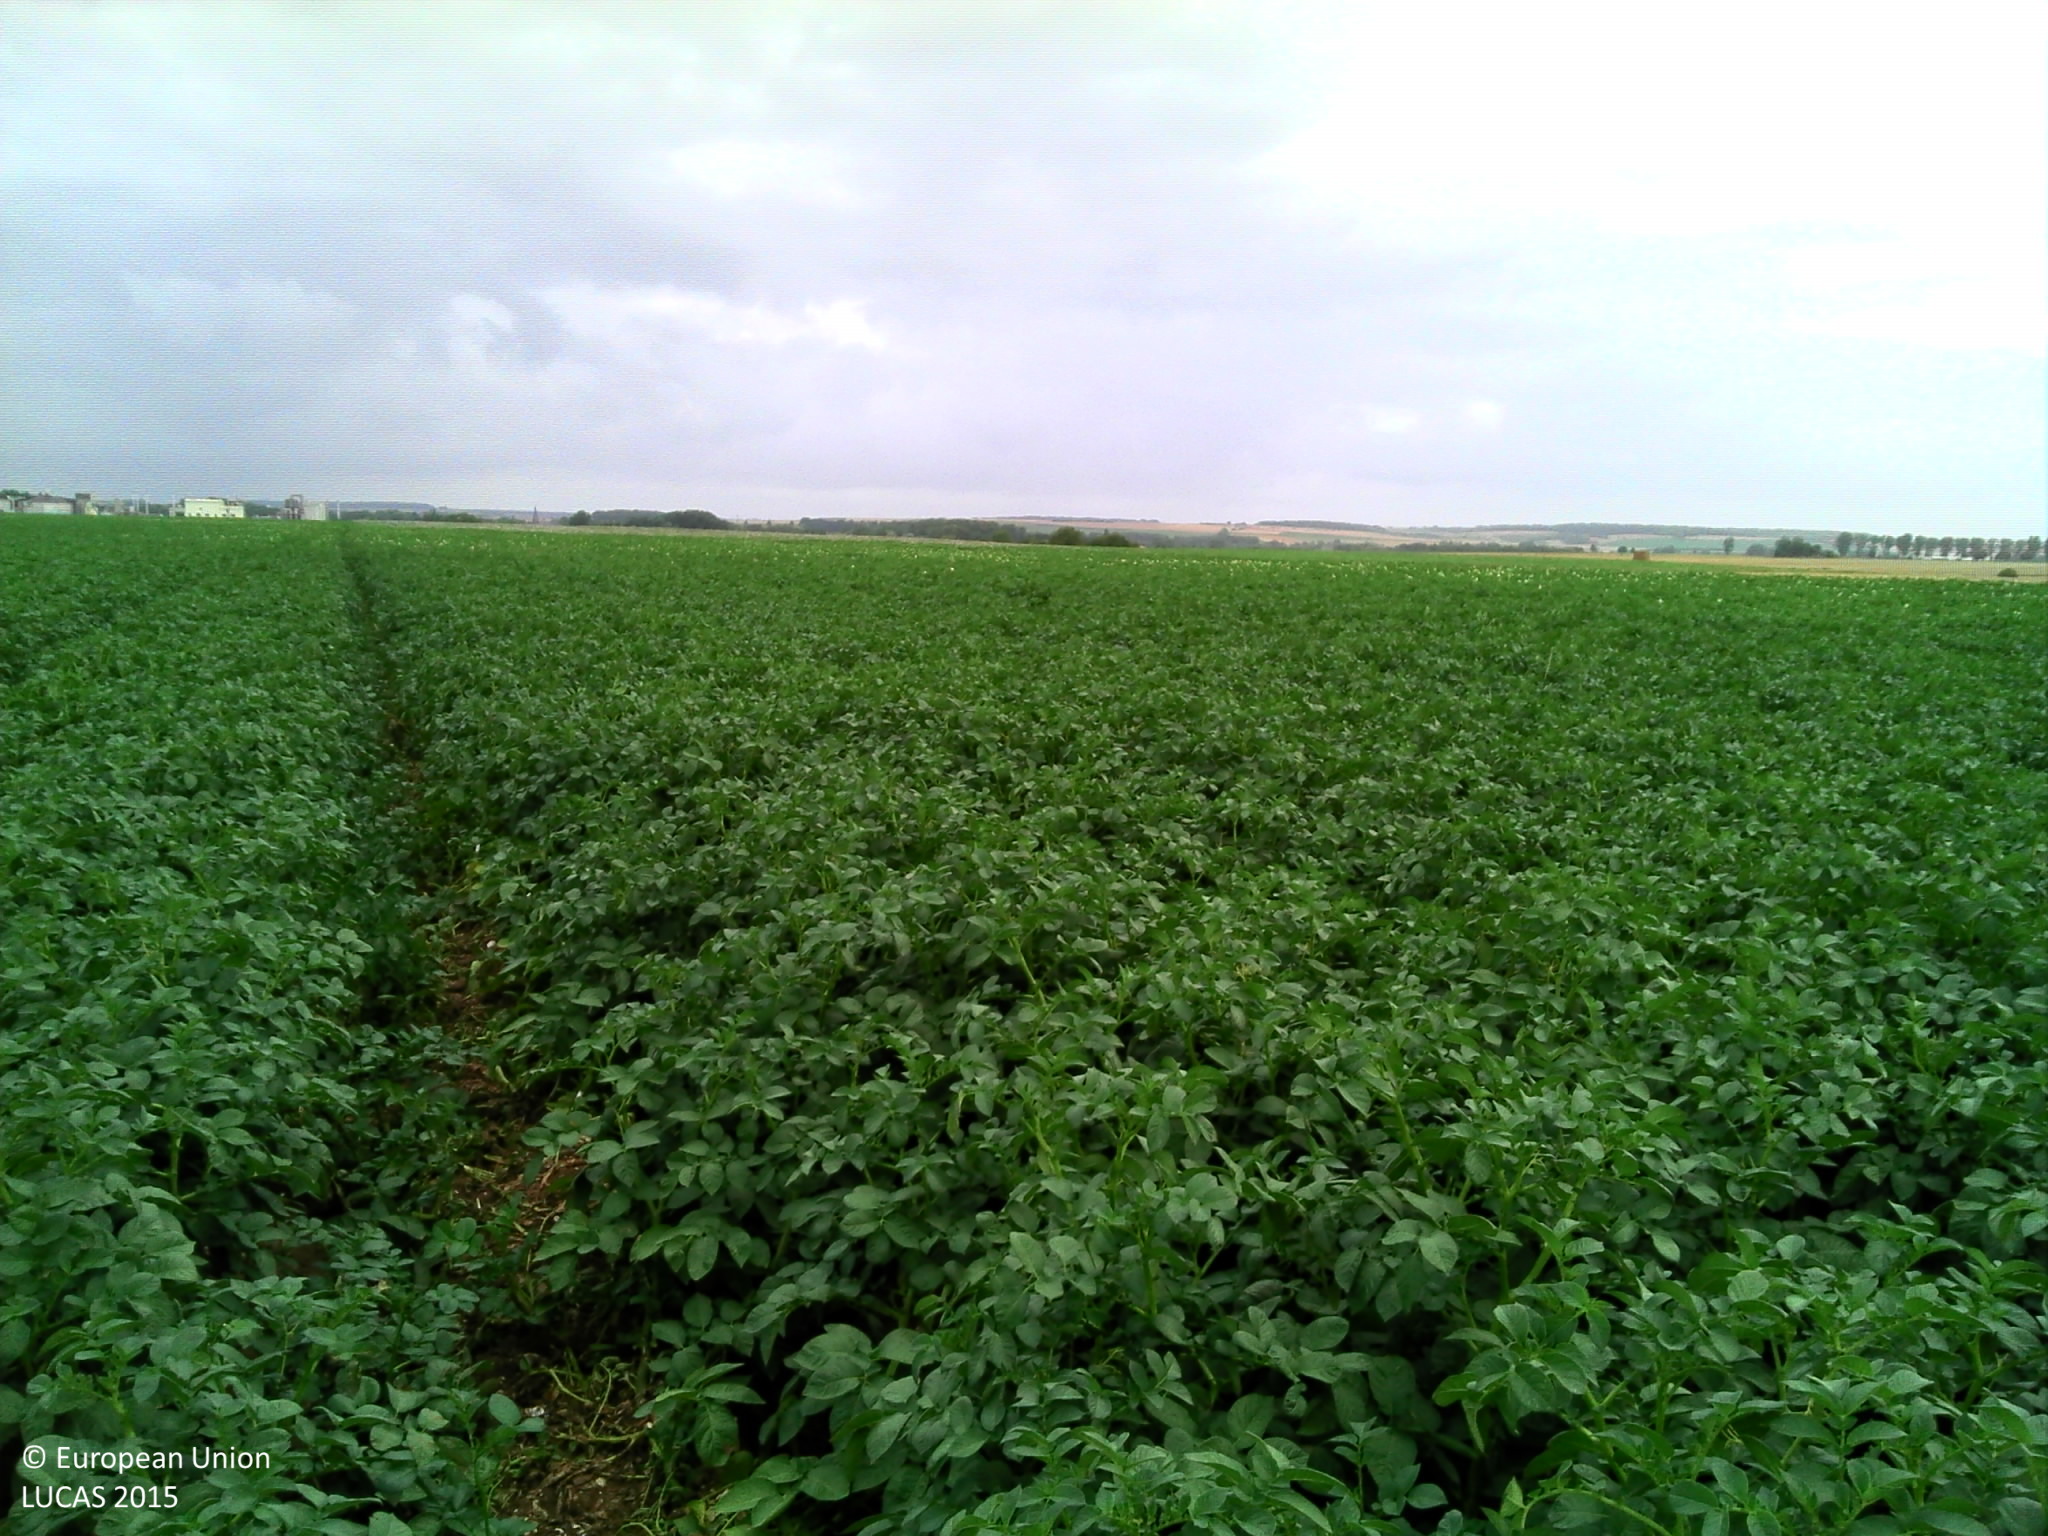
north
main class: Cropland
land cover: Potatoes
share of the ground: > 75 %
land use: Agriculture (excluding fallow land and kitchen gardens)
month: July
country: FR
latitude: 49.8801
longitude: 2.4587
